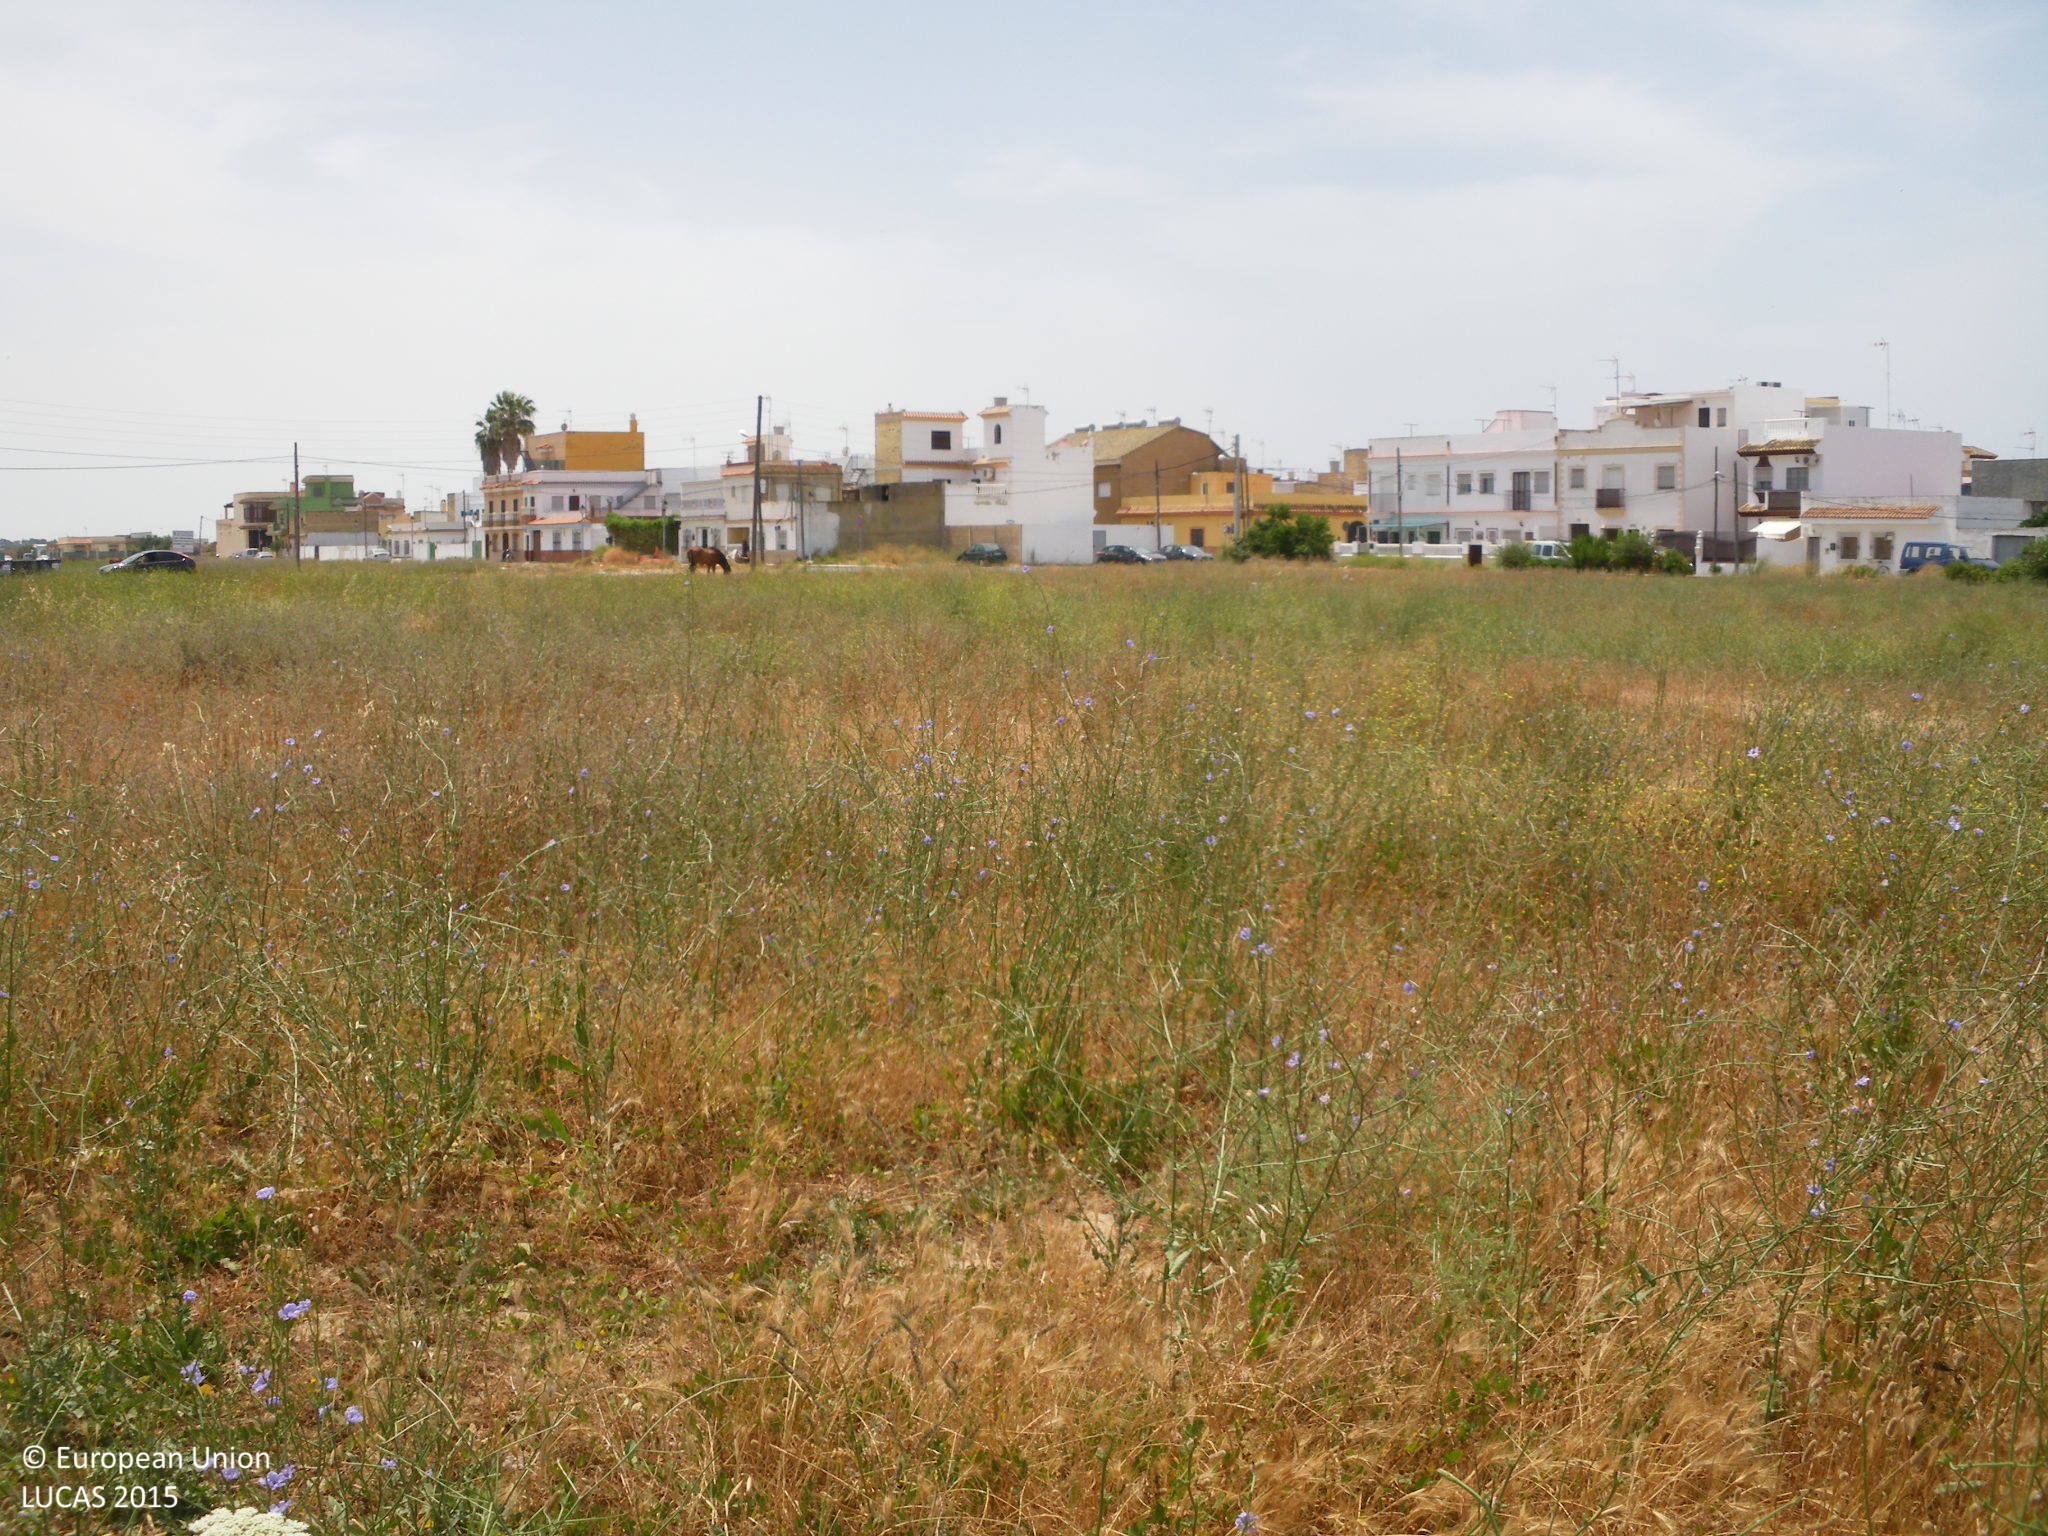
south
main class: Grassland
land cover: Grassland without tree/shrub cover
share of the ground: > 75 %
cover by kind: herbaceous plants 95 %, unconsolidated bare surface 5 %
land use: Agriculture (excluding fallow land and kitchen gardens)
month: June
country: ES
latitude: 36.7337
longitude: -6.4231
